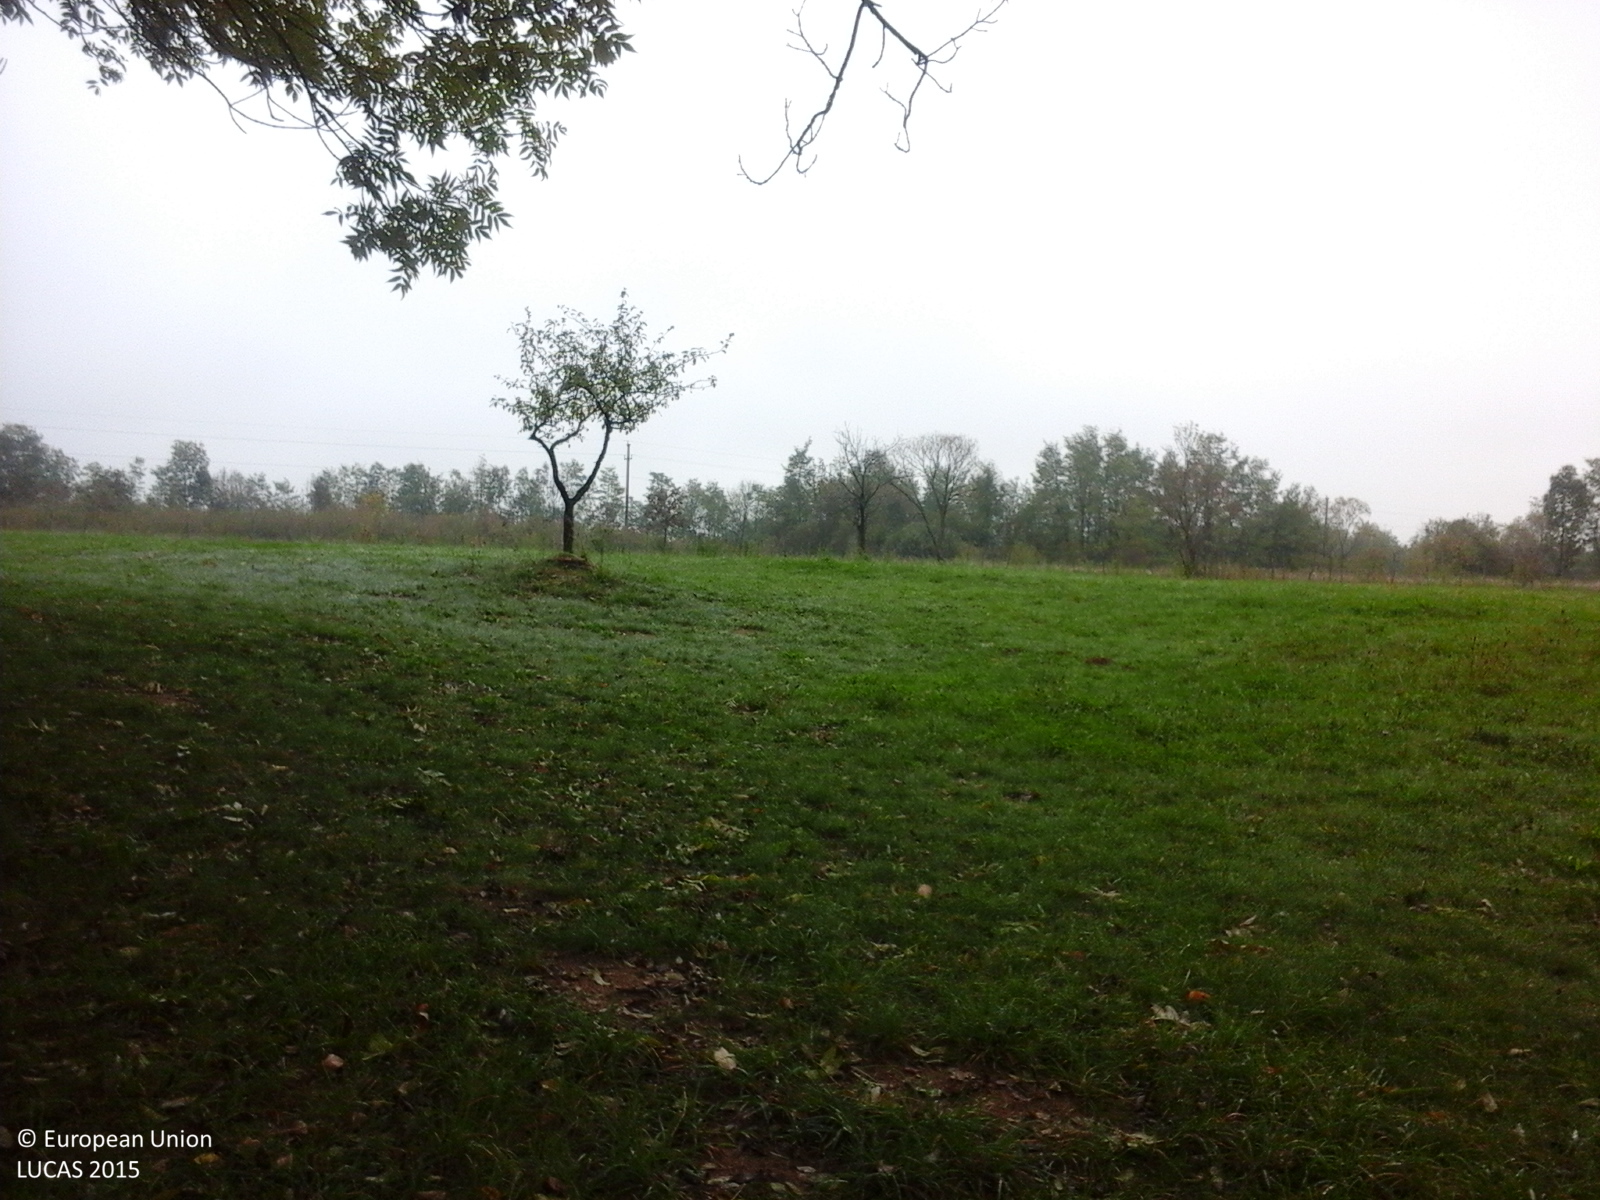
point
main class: Grassland
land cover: Grassland with sparse tree/shrub cover
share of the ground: > 75 %
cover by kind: herbaceous plants 95 %, broadleaved forest trees 5 %
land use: Agriculture (excluding fallow land and kitchen gardens)
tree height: > 5 m
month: October
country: RO
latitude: 45.7209
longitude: 24.9032
